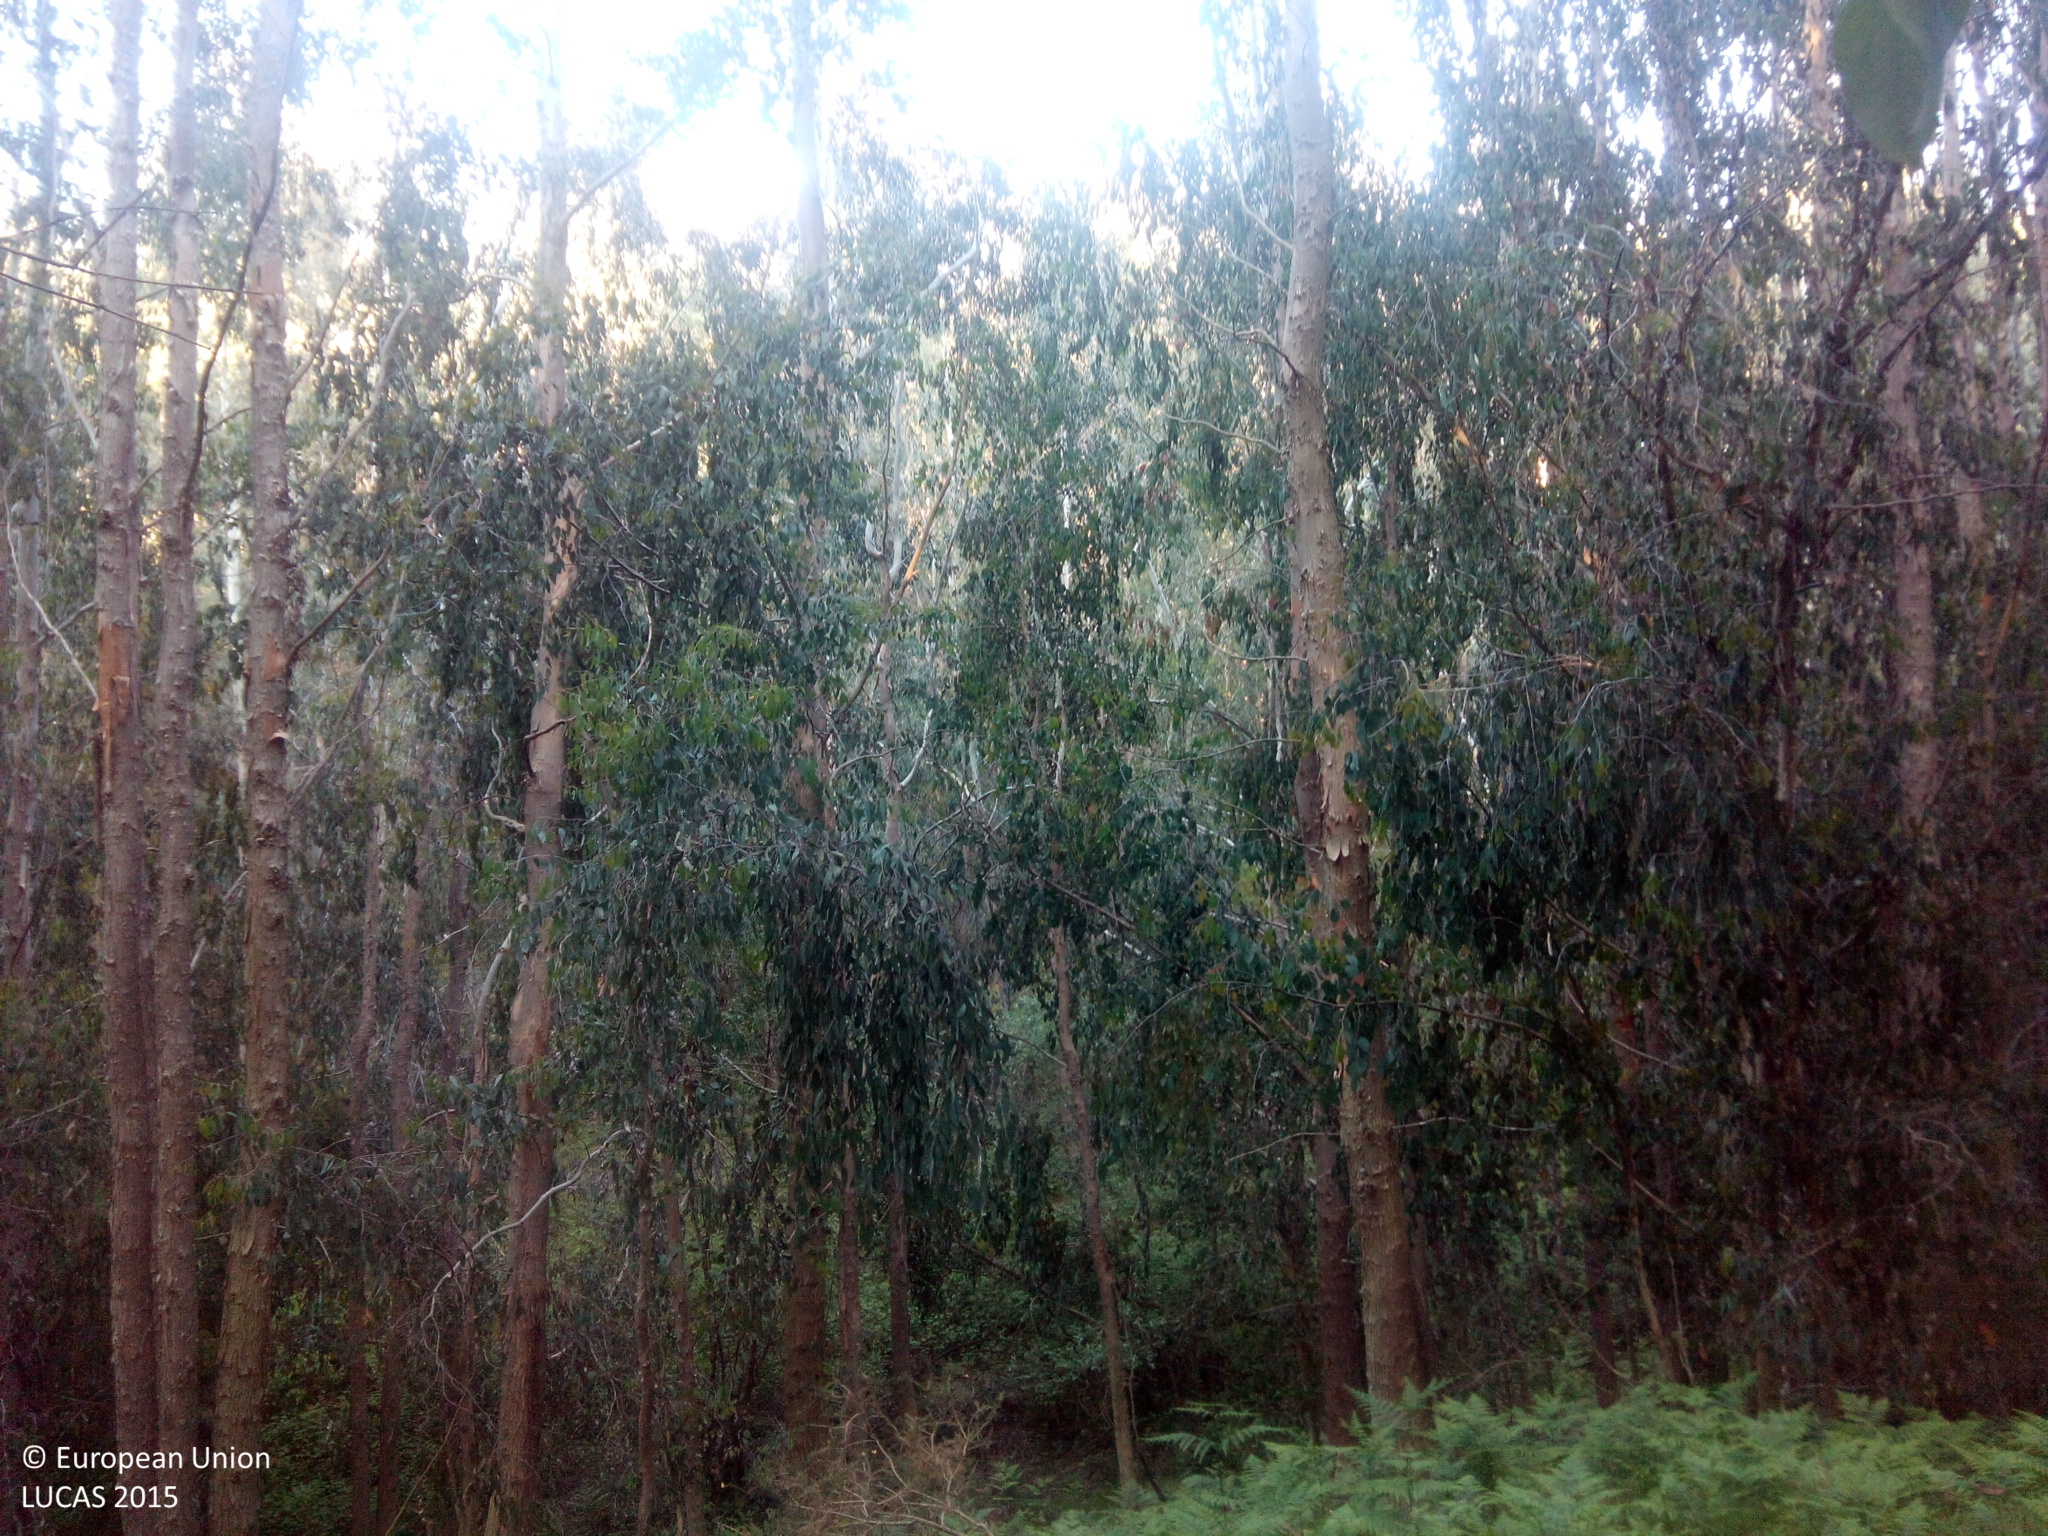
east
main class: Woodland
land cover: Broadleaved woodland
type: exotic forest
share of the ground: > 75 %
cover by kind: broadleaved forest trees 70 %, shrubs 20 %, herbaceous plants 10 %
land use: Forestry
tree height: > 5 m
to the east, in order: Broadleaved woodland; Rivers and streams; Grassland with sparse tree/shrub cover; Broadleaved woodland; Tracks; Ditches and canals; Grassland without tree/shrub cover
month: June
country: ES
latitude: 42.2218
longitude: -8.3218
